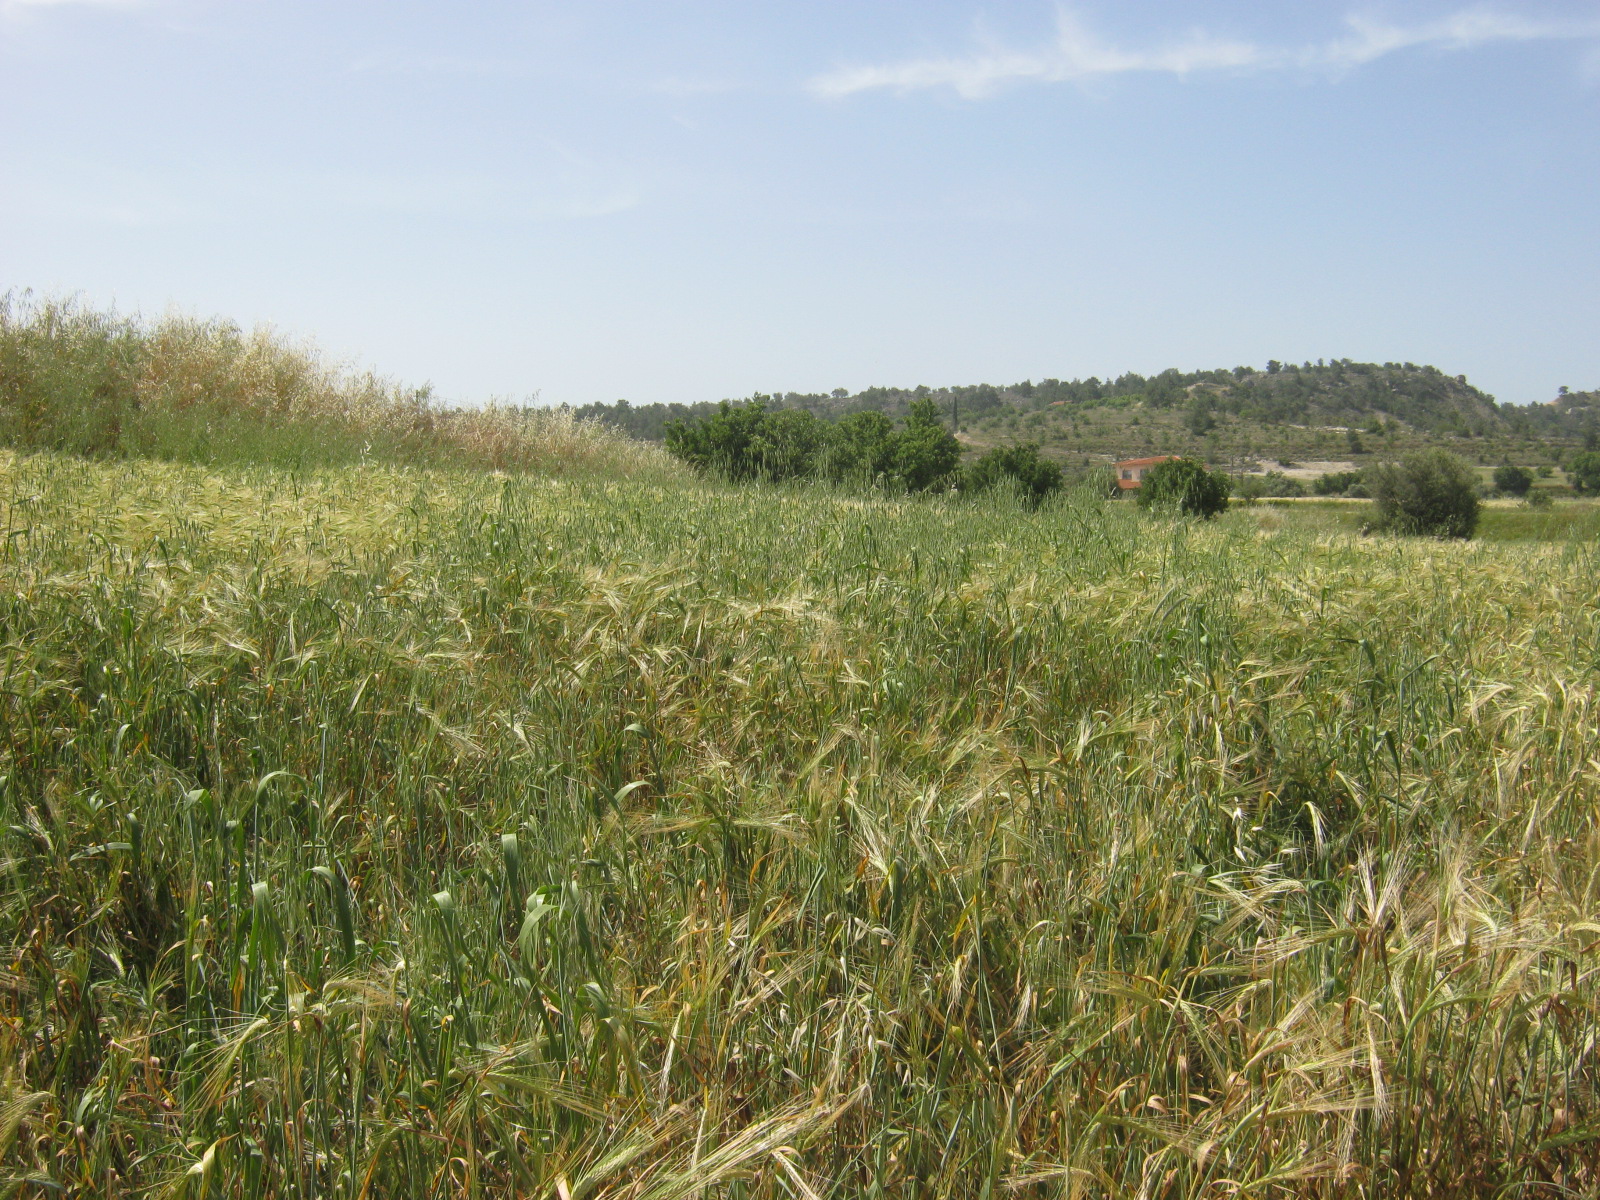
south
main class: Cropland
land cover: Barley
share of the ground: > 75 %
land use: Agriculture (excluding fallow land and kitchen gardens)
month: May
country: CY
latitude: 35.0335
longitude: 33.2358
